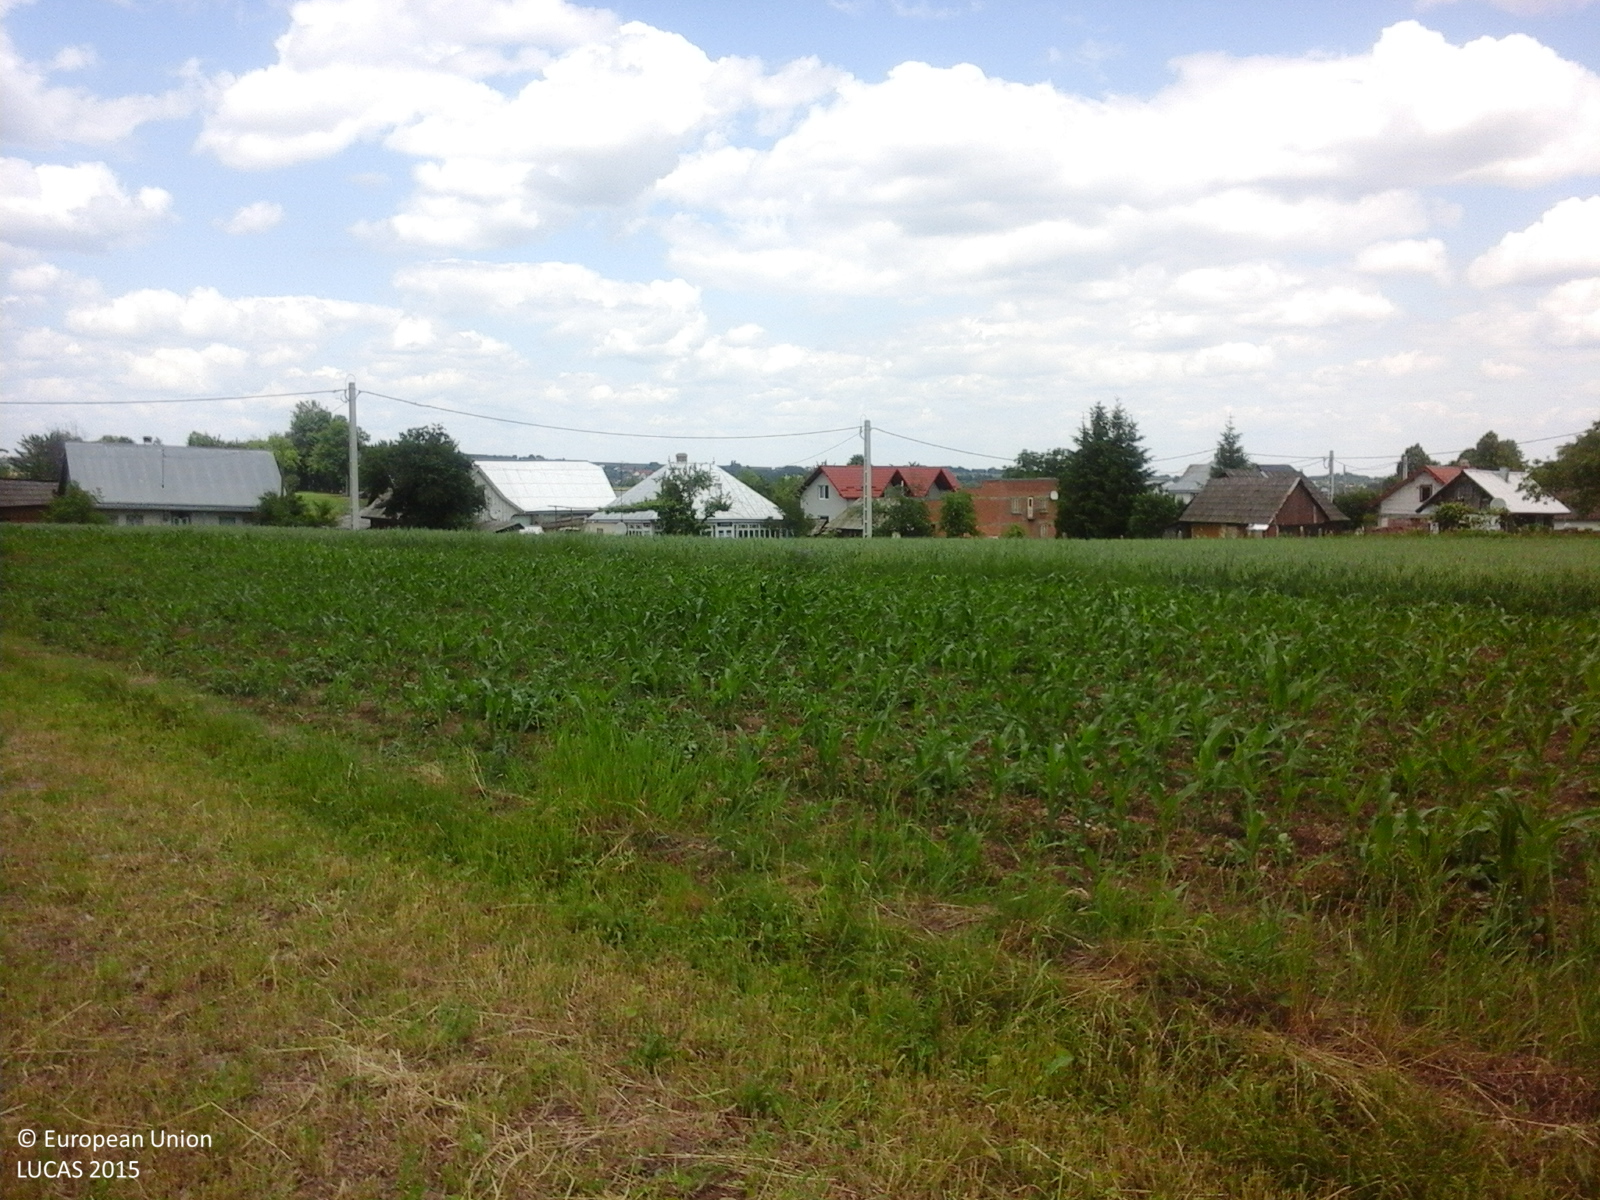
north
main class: Grassland
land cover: Grassland without tree/shrub cover
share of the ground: > 75 %
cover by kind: herbaceous plants 100 %
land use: Agriculture (excluding fallow land and kitchen gardens)
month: June
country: RO
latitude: 47.8408
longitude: 25.8265
